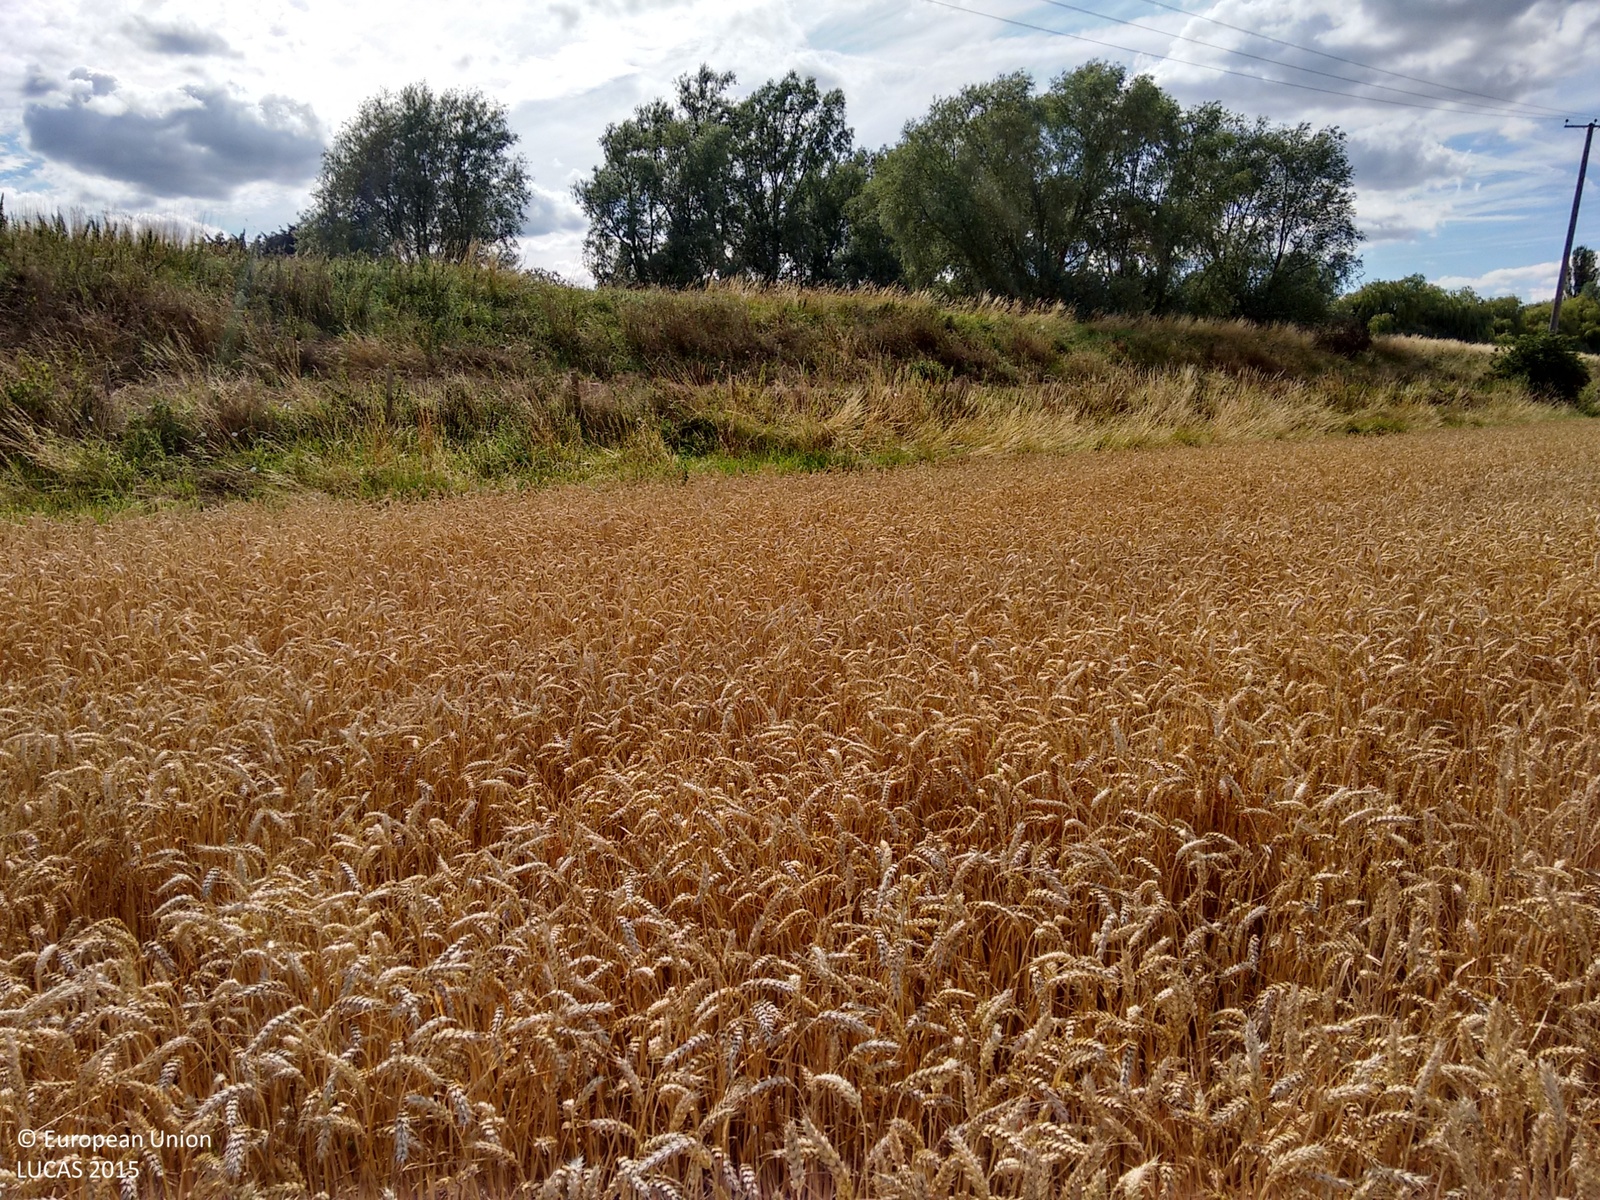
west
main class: Cropland
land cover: Common wheat
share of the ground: > 75 %
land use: Agriculture (excluding fallow land and kitchen gardens)
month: August
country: GB
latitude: 52.4446
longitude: 0.4532
